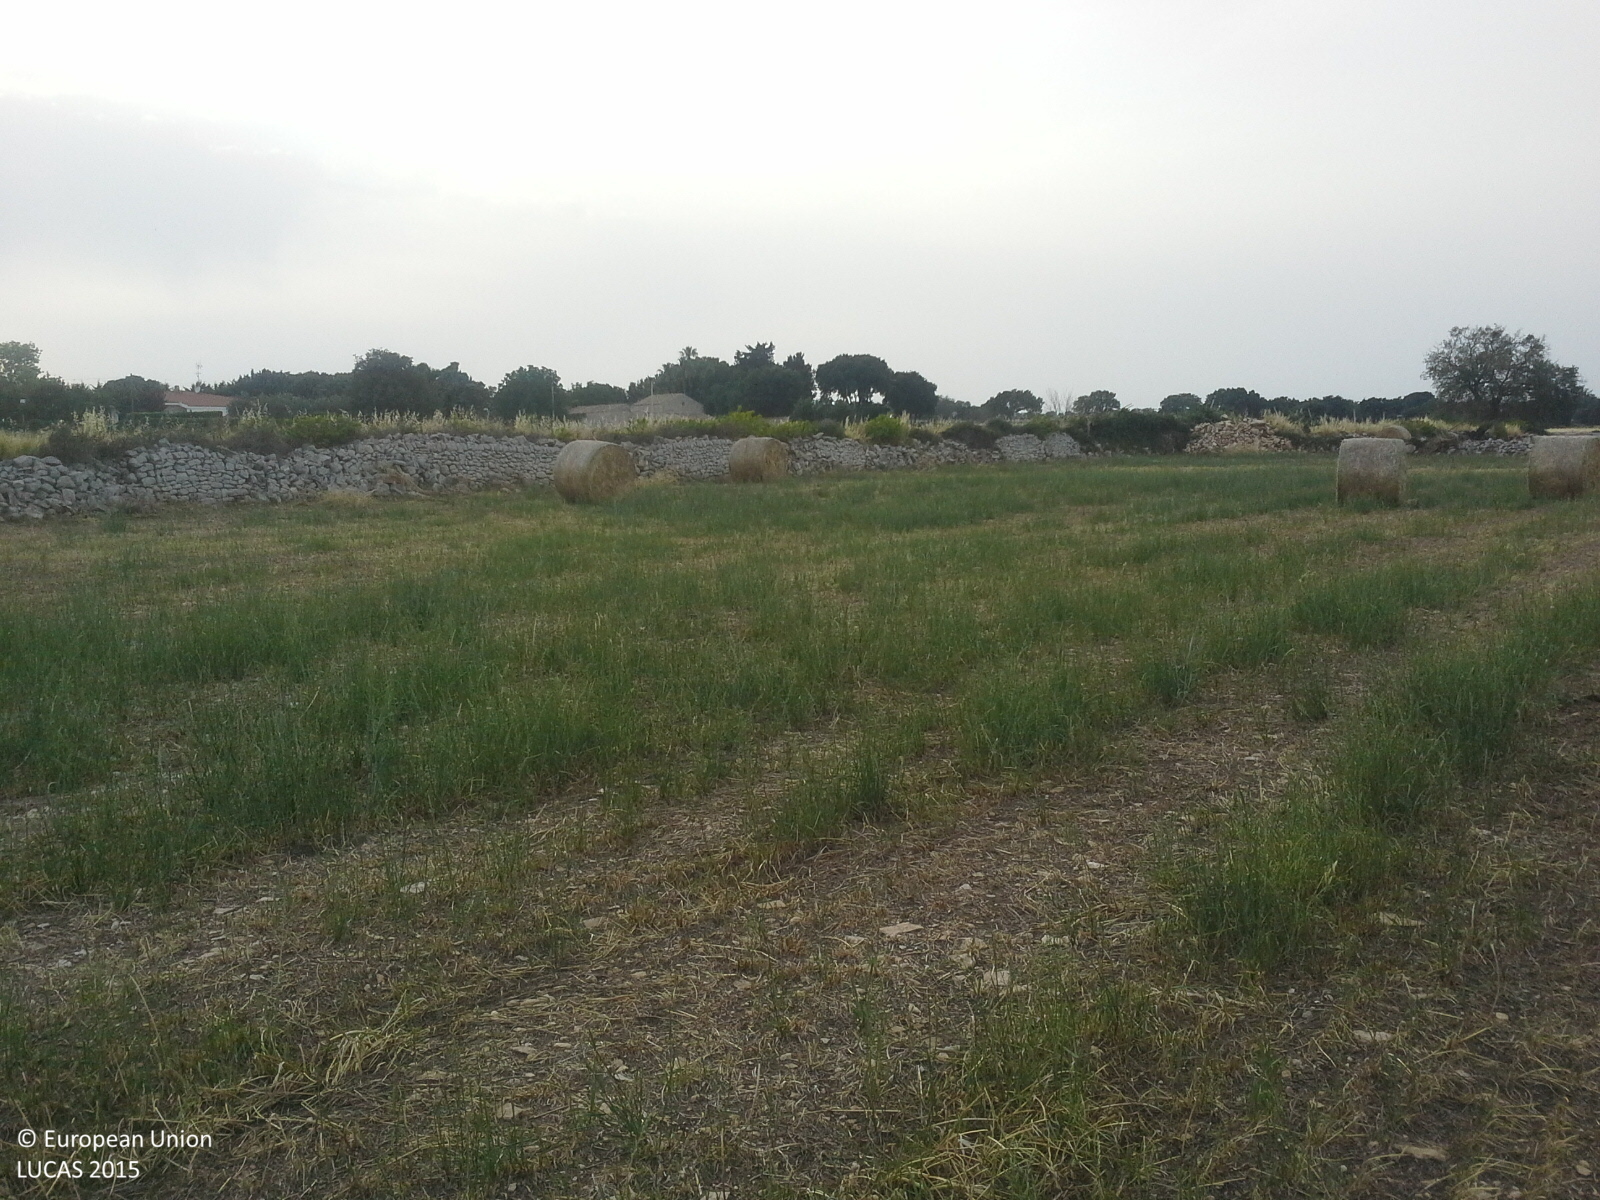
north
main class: Cropland
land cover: Mixed cereals for fodder
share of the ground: > 75 %
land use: Agriculture (excluding fallow land and kitchen gardens)
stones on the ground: < 10 %
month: May
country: IT
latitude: 36.8795
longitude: 14.8196
